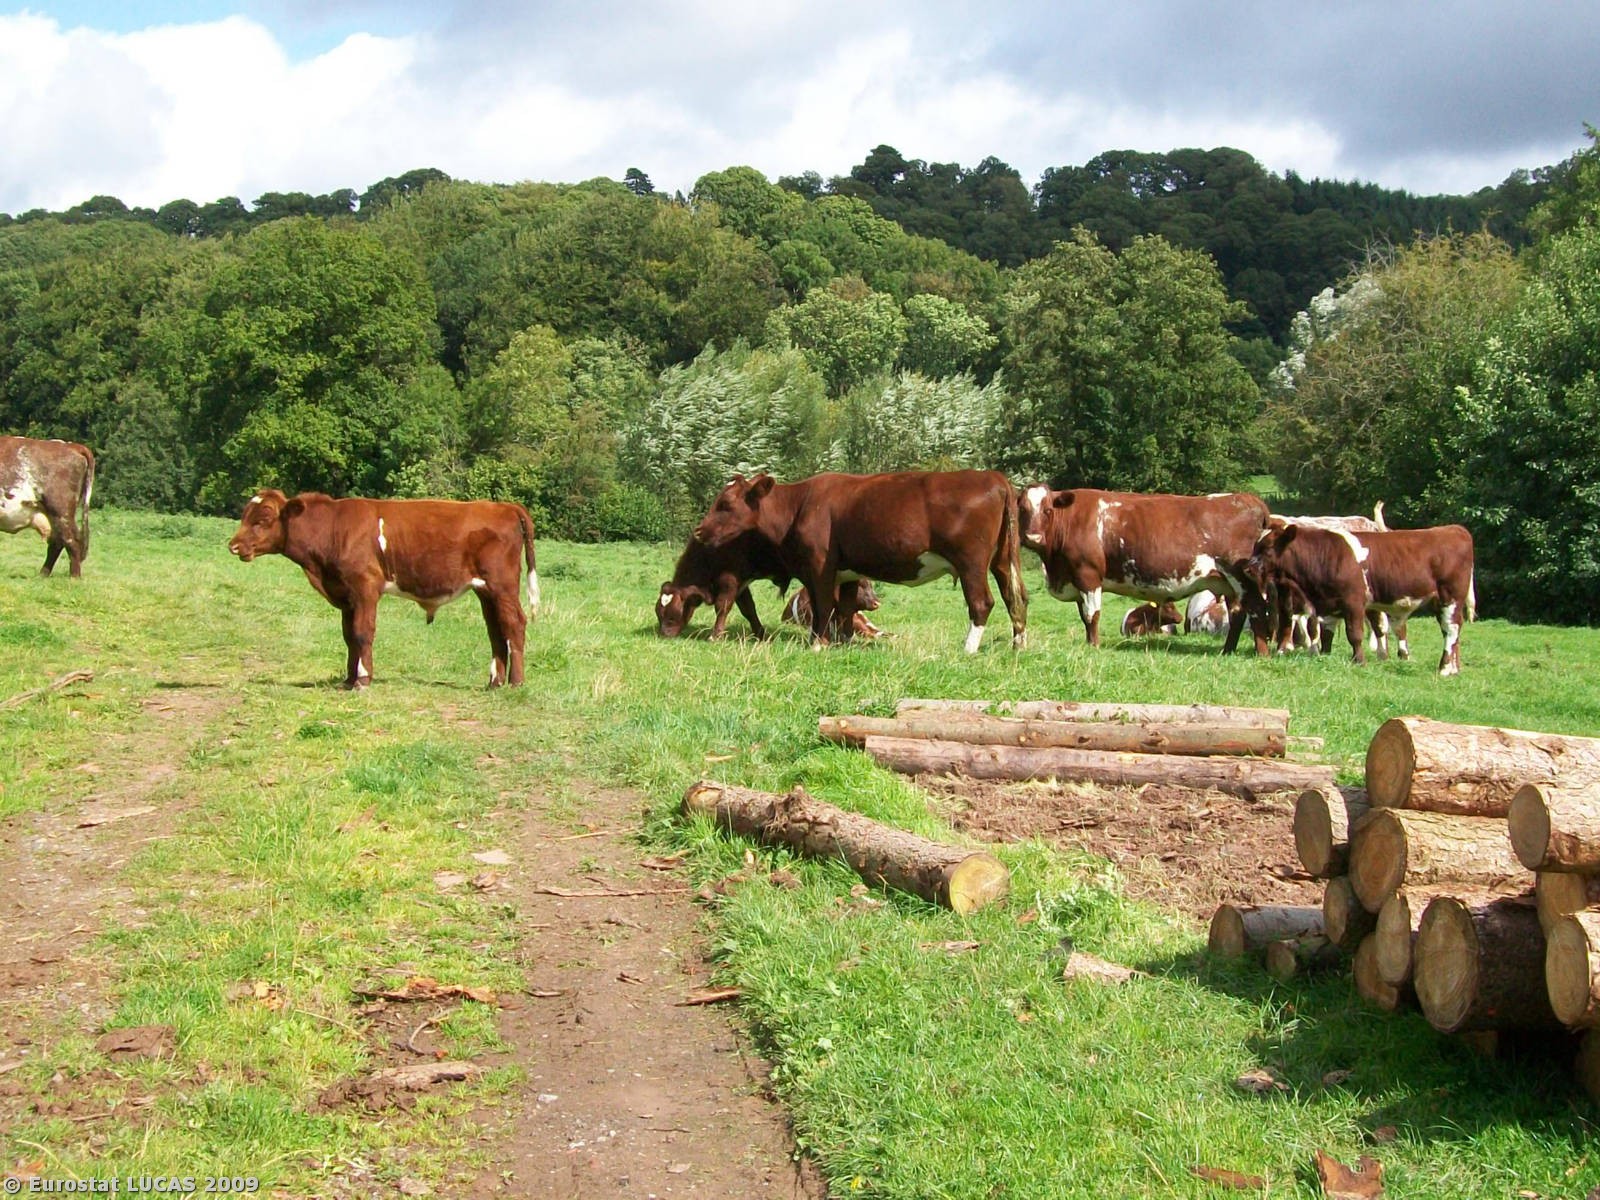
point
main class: Grassland
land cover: Grassland without tree/shrub cover
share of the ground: > 75 %
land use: Agriculture (excluding fallow land and kitchen gardens)
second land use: Community services
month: September
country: GB
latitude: 52.2122
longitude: -2.4320
